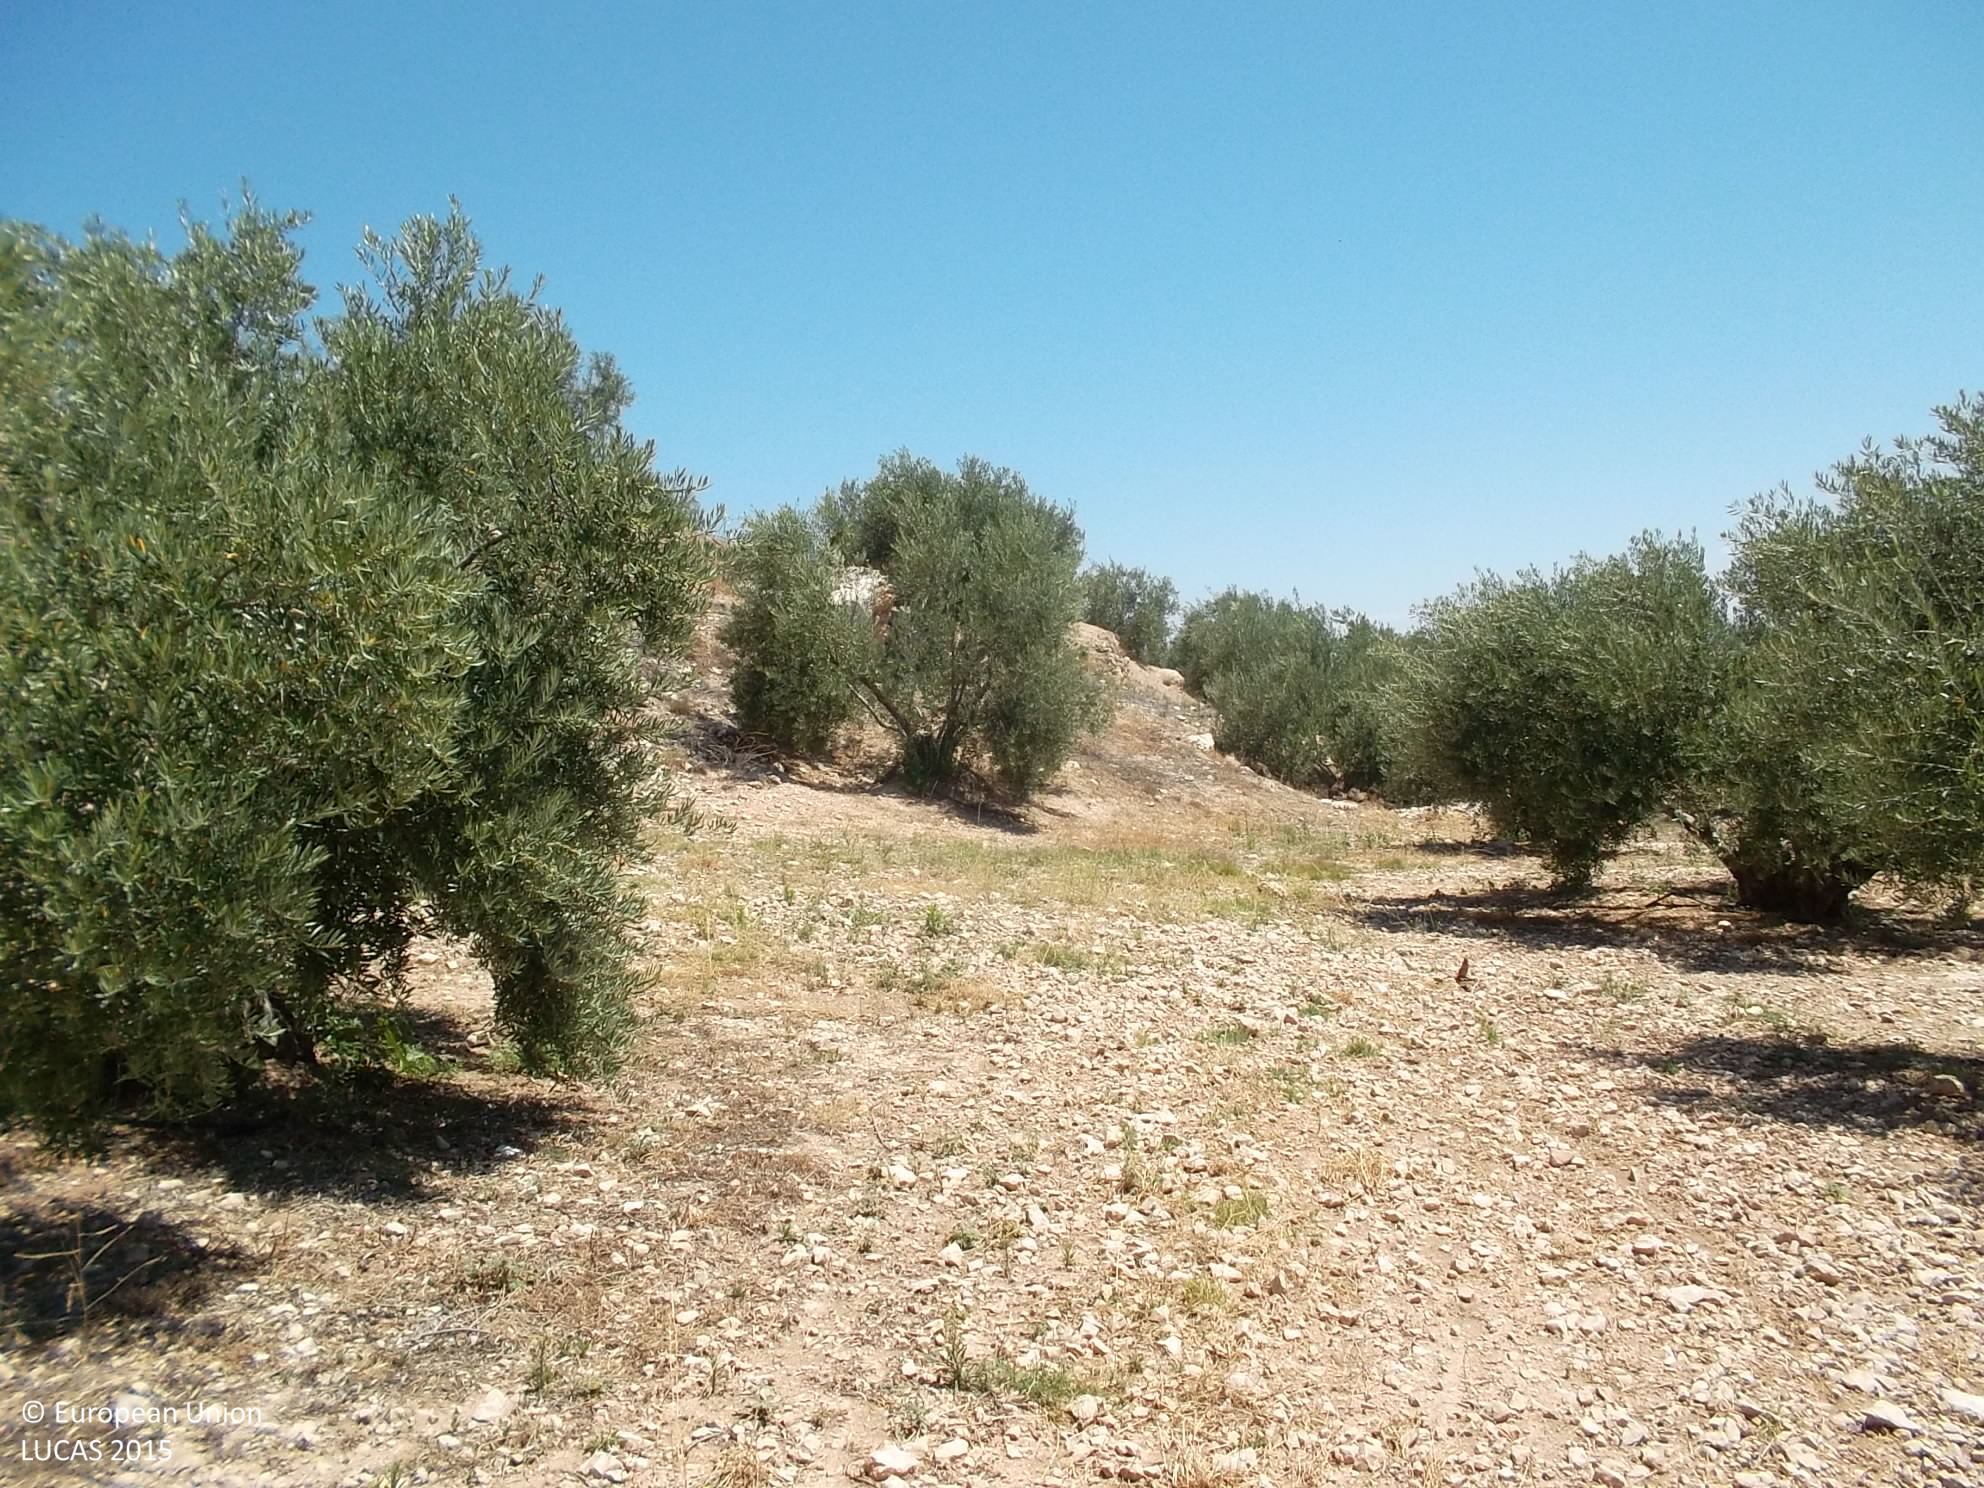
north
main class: Cropland
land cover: Olive groves
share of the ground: 25 - 50 %
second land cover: Grassland without tree/shrub cover
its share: 10 - 25 %
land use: Agriculture (excluding fallow land and kitchen gardens)
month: June
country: ES
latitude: 37.8265
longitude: -3.3694
